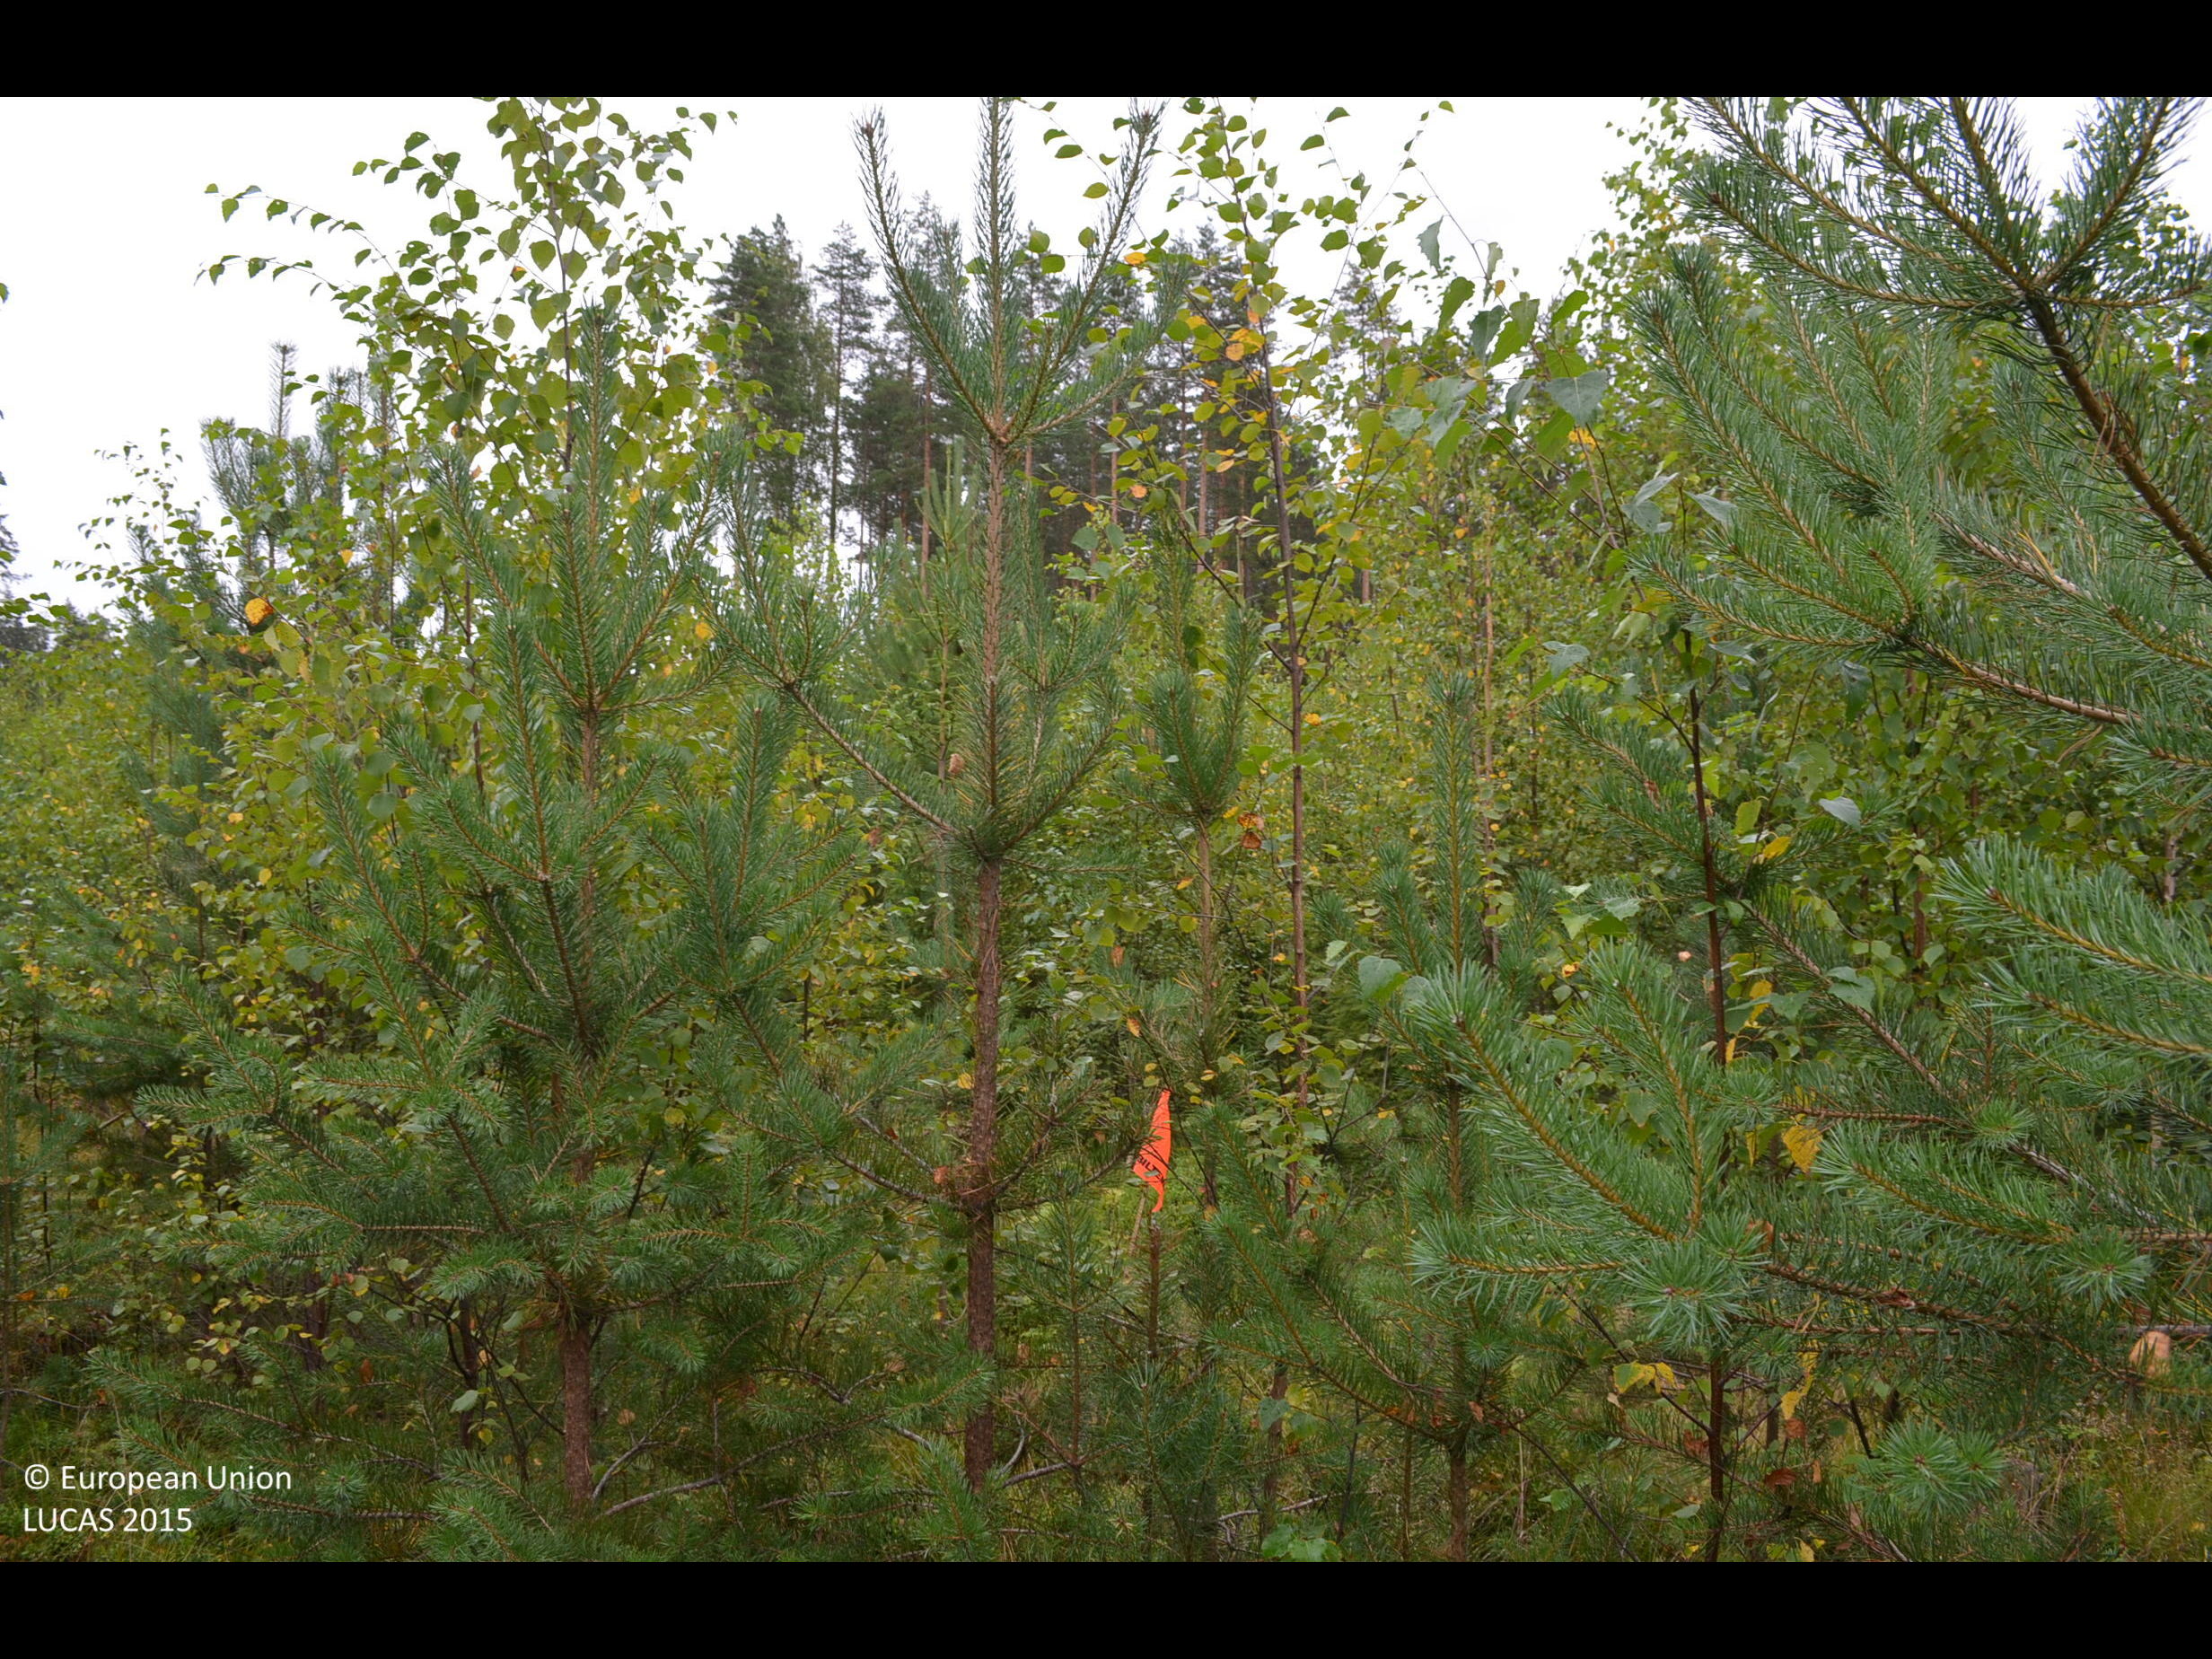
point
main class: Woodland
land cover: Pine dominated mixed woodland
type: boreal forest
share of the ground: > 75 %
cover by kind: coniferous forest trees 50 %, broadleaved forest trees 30 %, shrubs 20 %
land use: Forestry
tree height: < 5 m
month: August
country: FI
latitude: 62.1874
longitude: 24.2466
